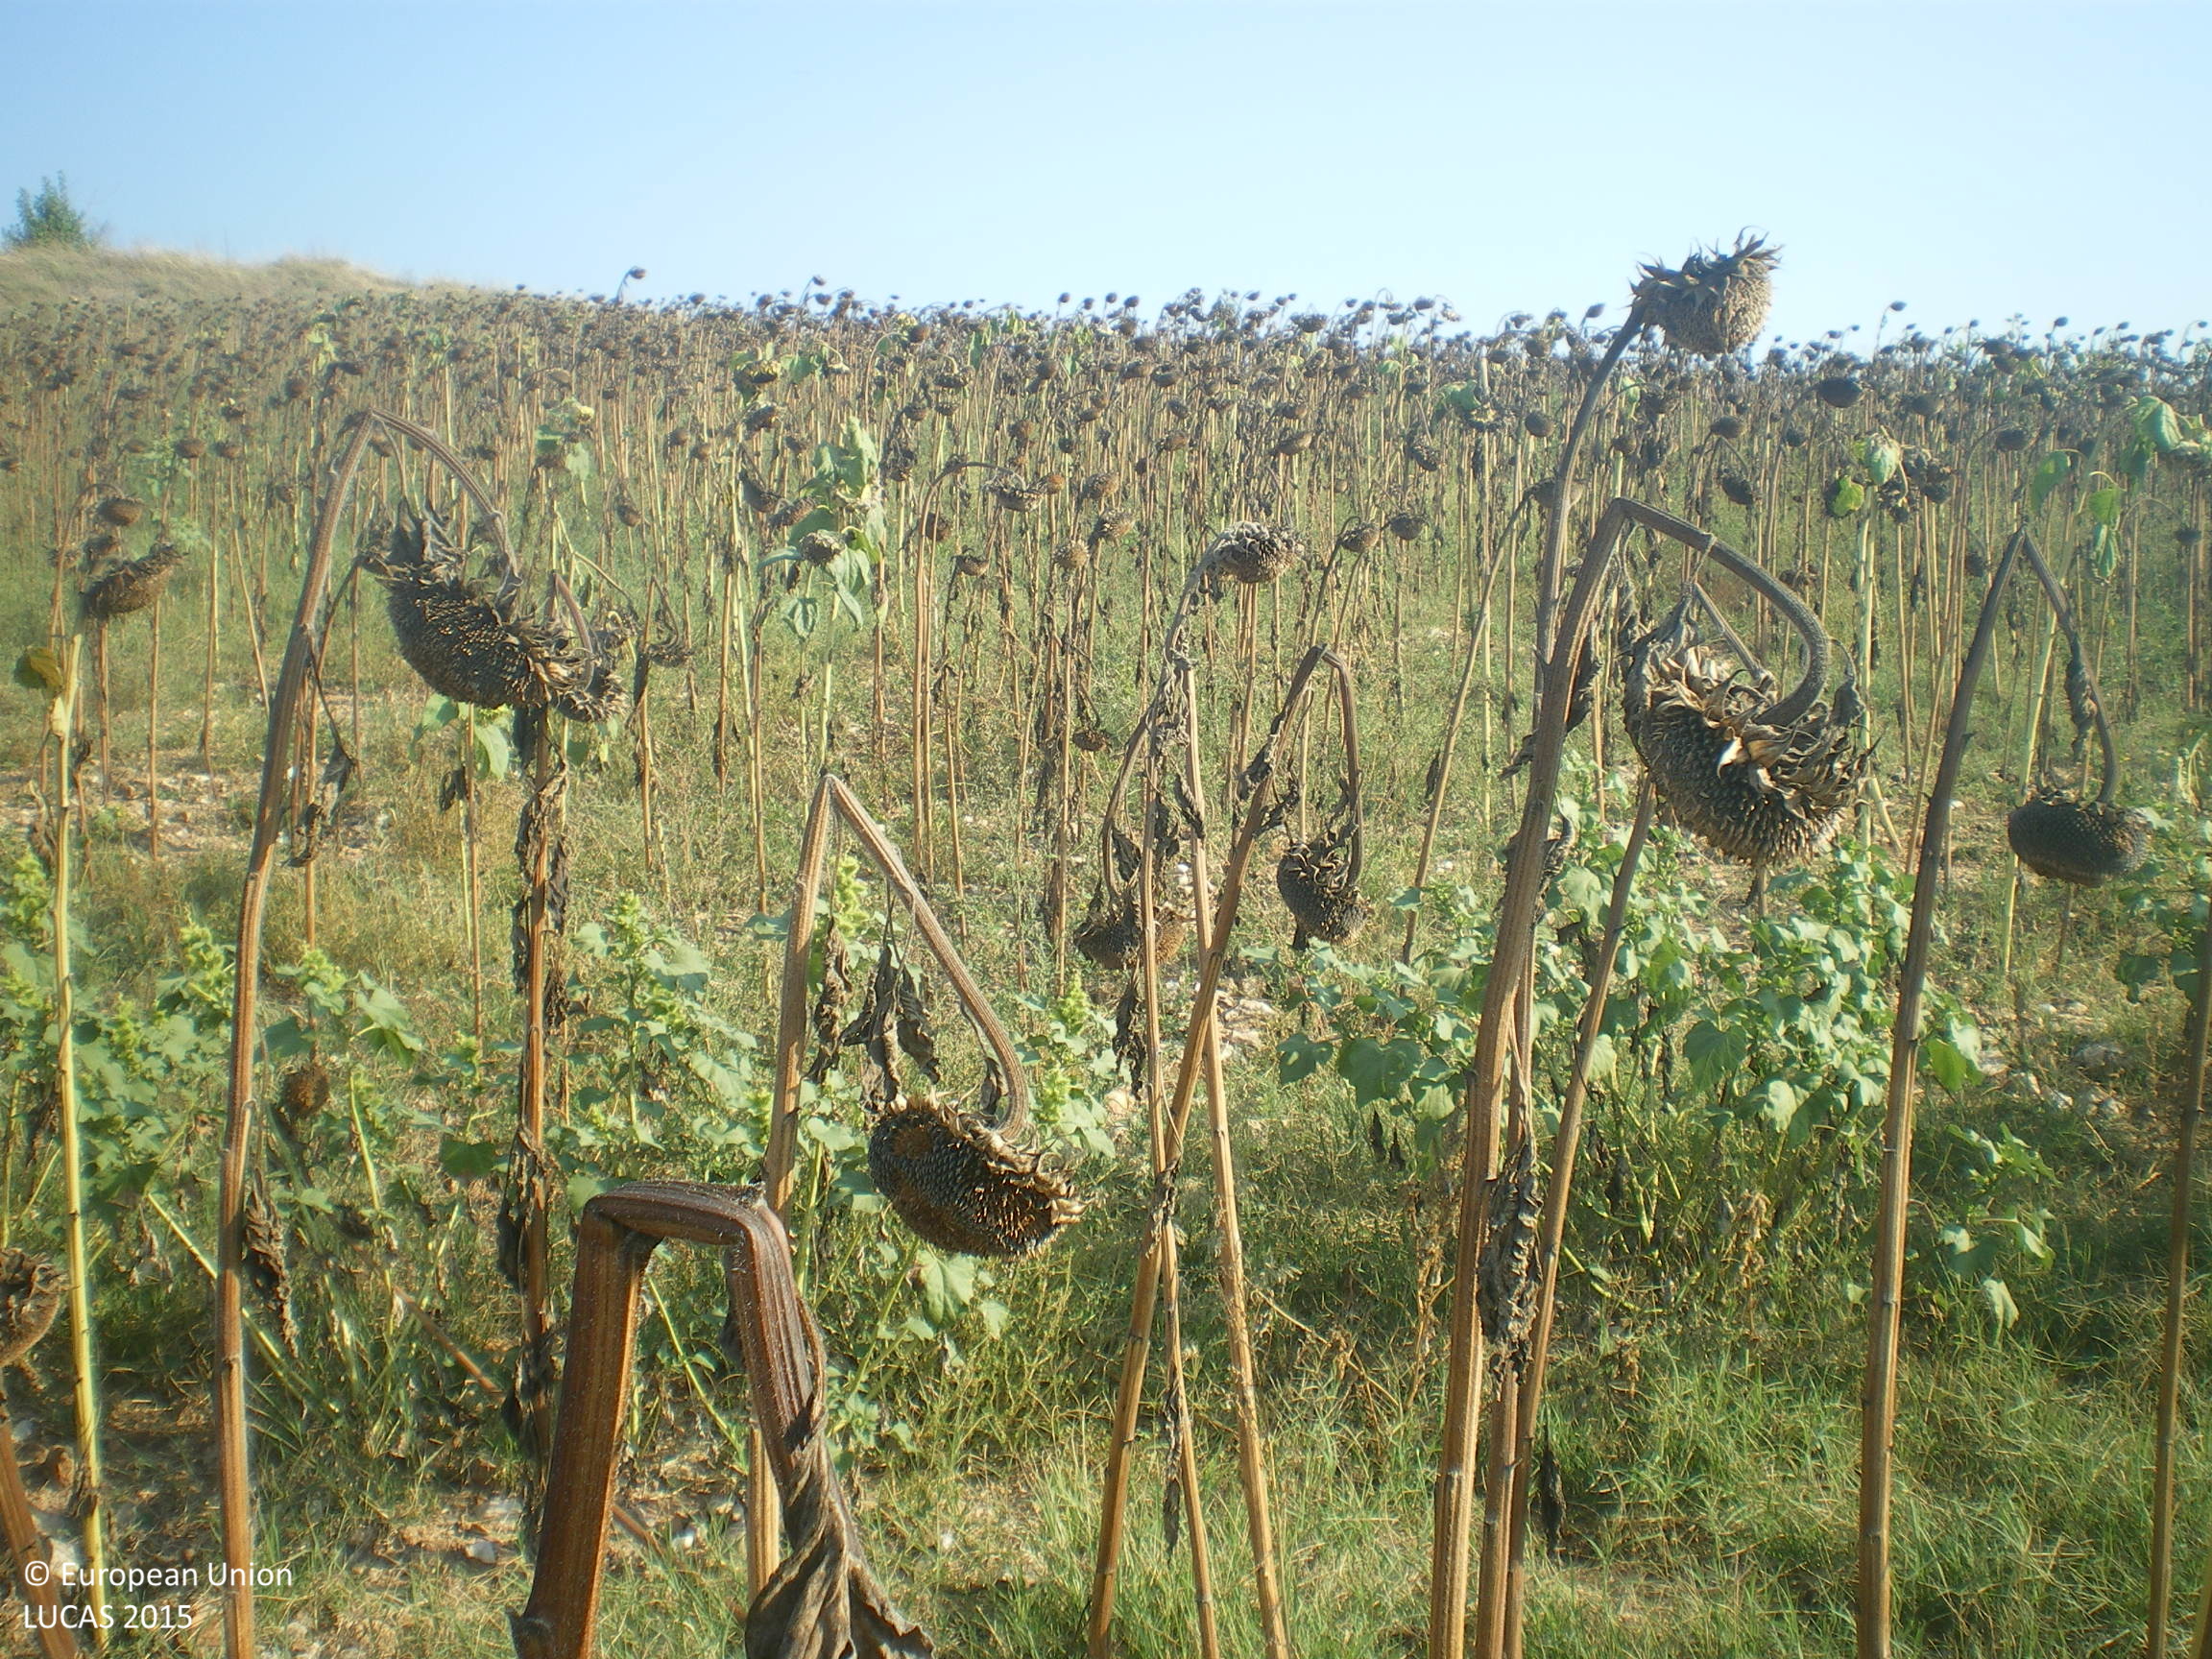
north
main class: Cropland
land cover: Sunflower
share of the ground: > 75 %
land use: Agriculture (excluding fallow land and kitchen gardens)
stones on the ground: > 50 %
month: August
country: BG
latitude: 42.0266
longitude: 25.9315
